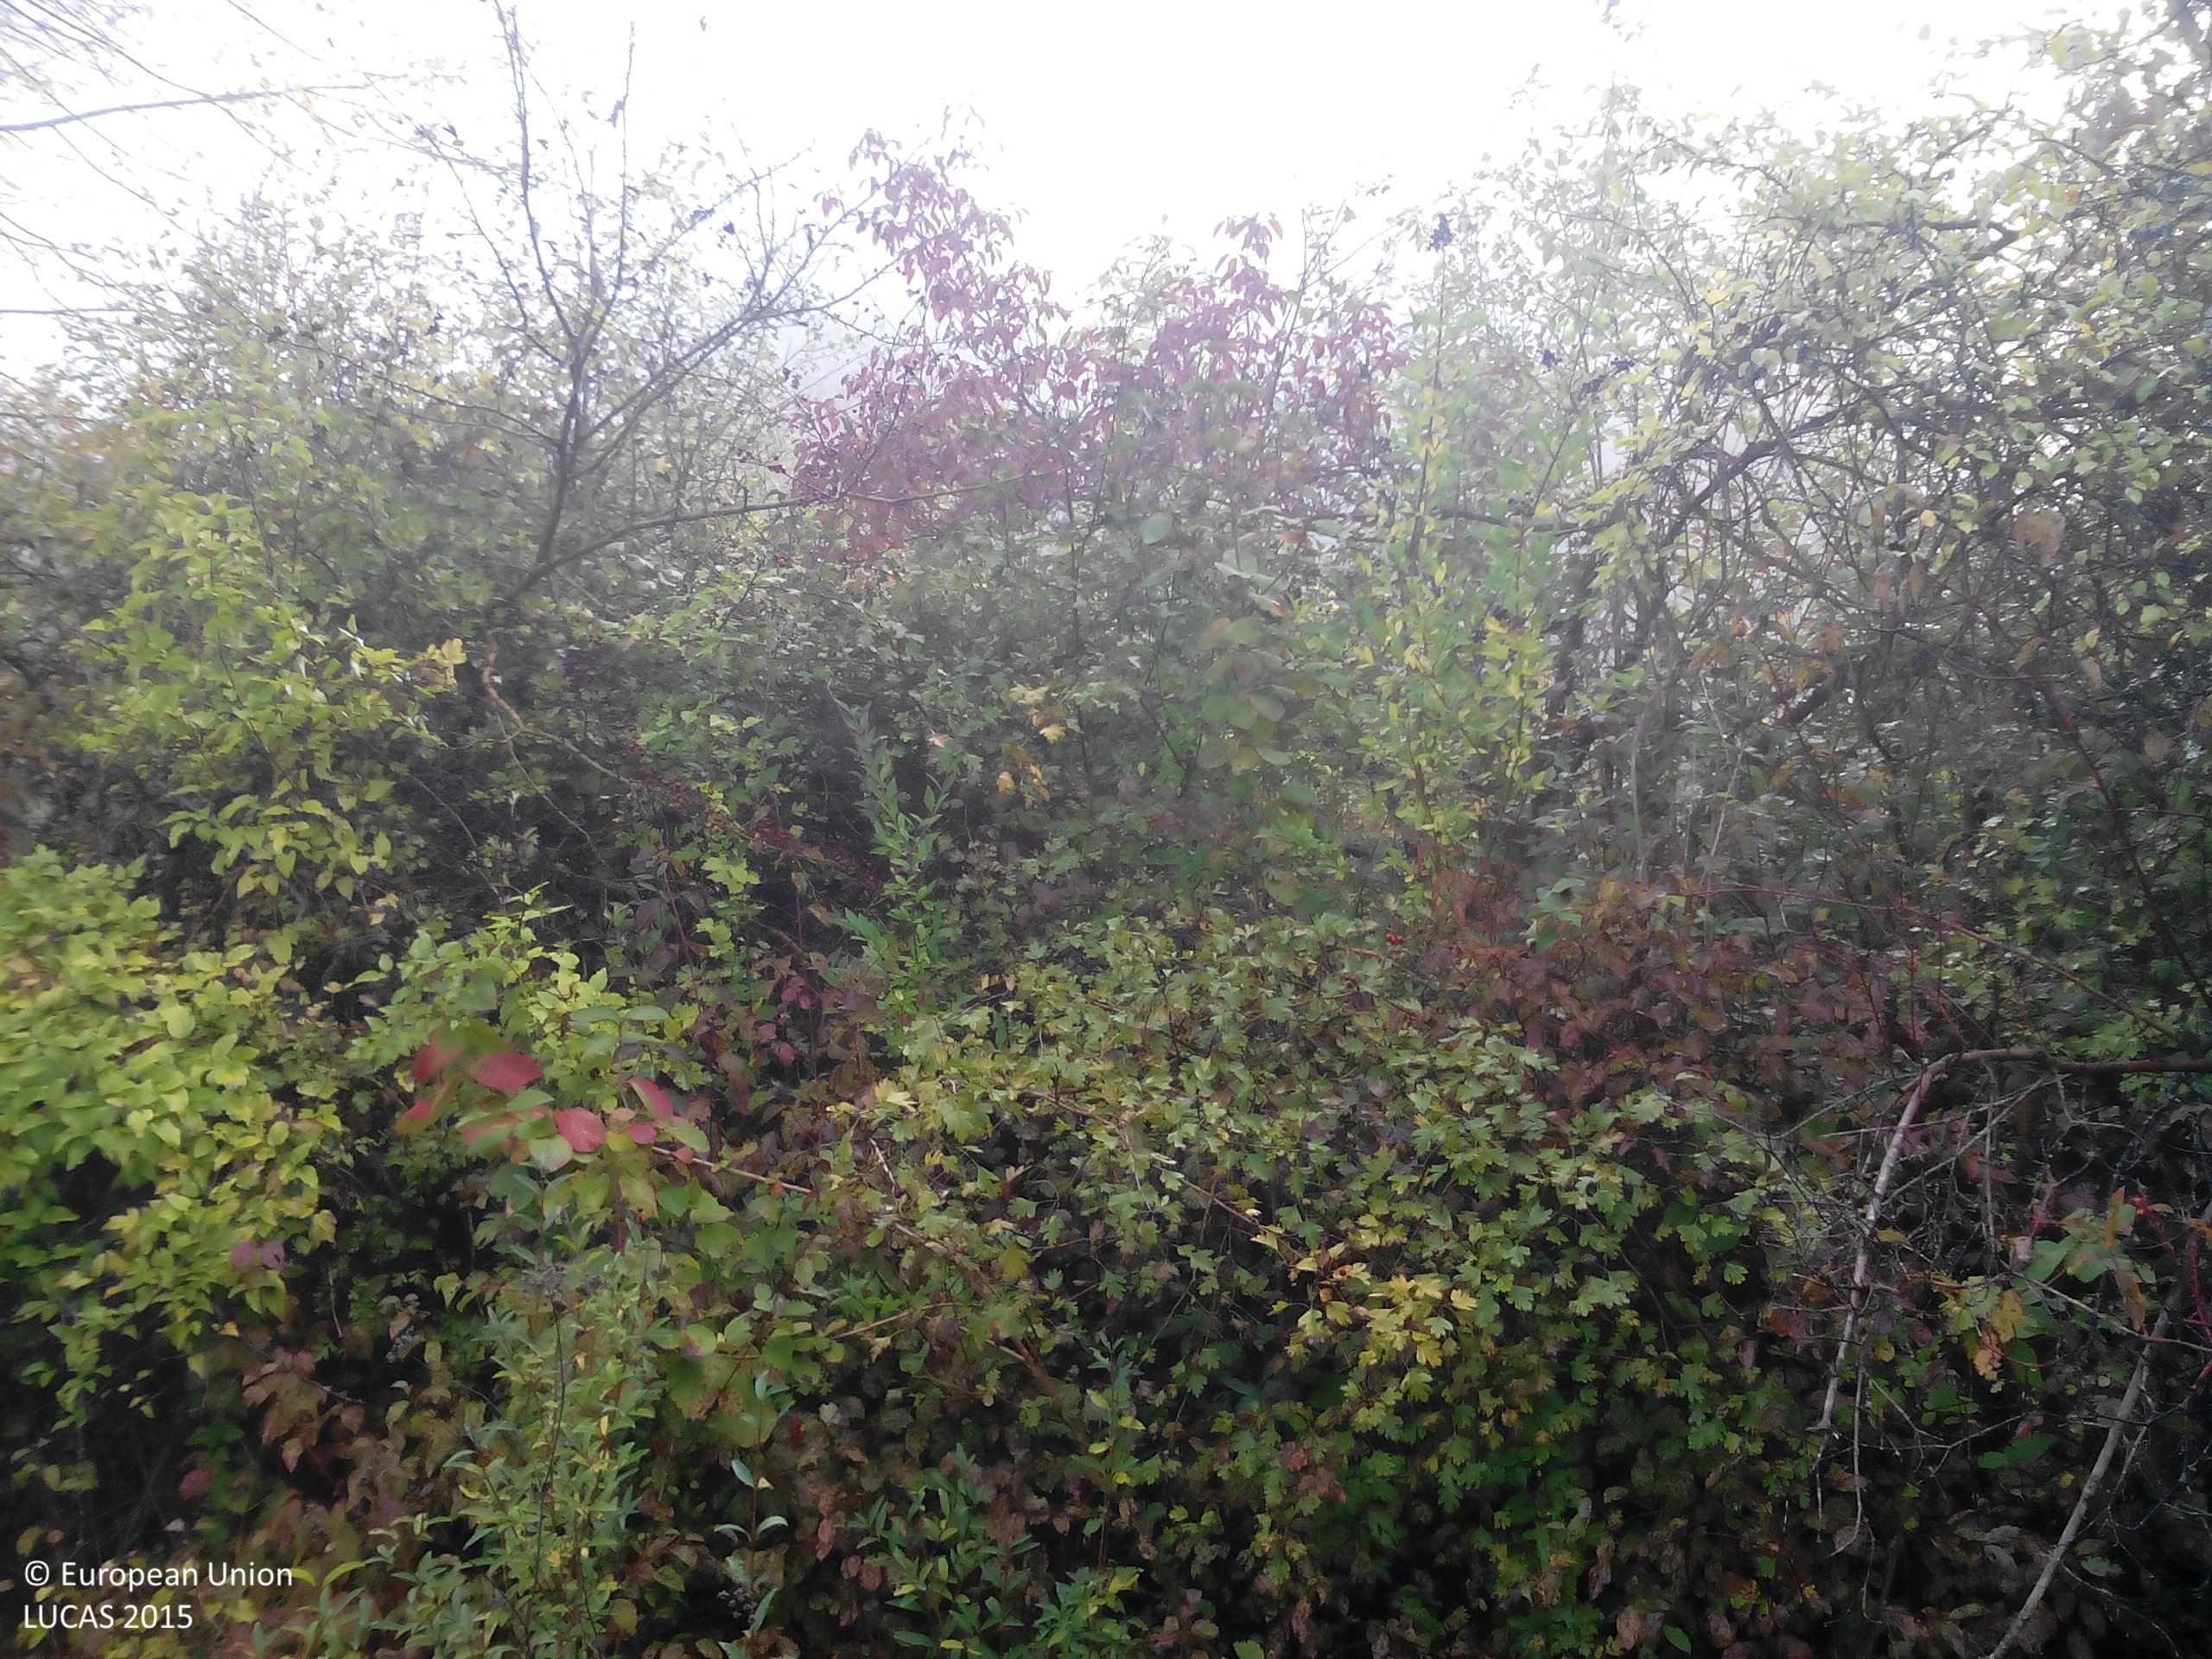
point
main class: Woodland
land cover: Broadleaved woodland
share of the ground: 50 - 75 %
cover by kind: shrubs 50 %, herbaceous plants 30 %, broadleaved forest trees 20 %
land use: Abandoned areas
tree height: > 5 m
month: October
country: BG
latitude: 42.9634
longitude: 24.0860
